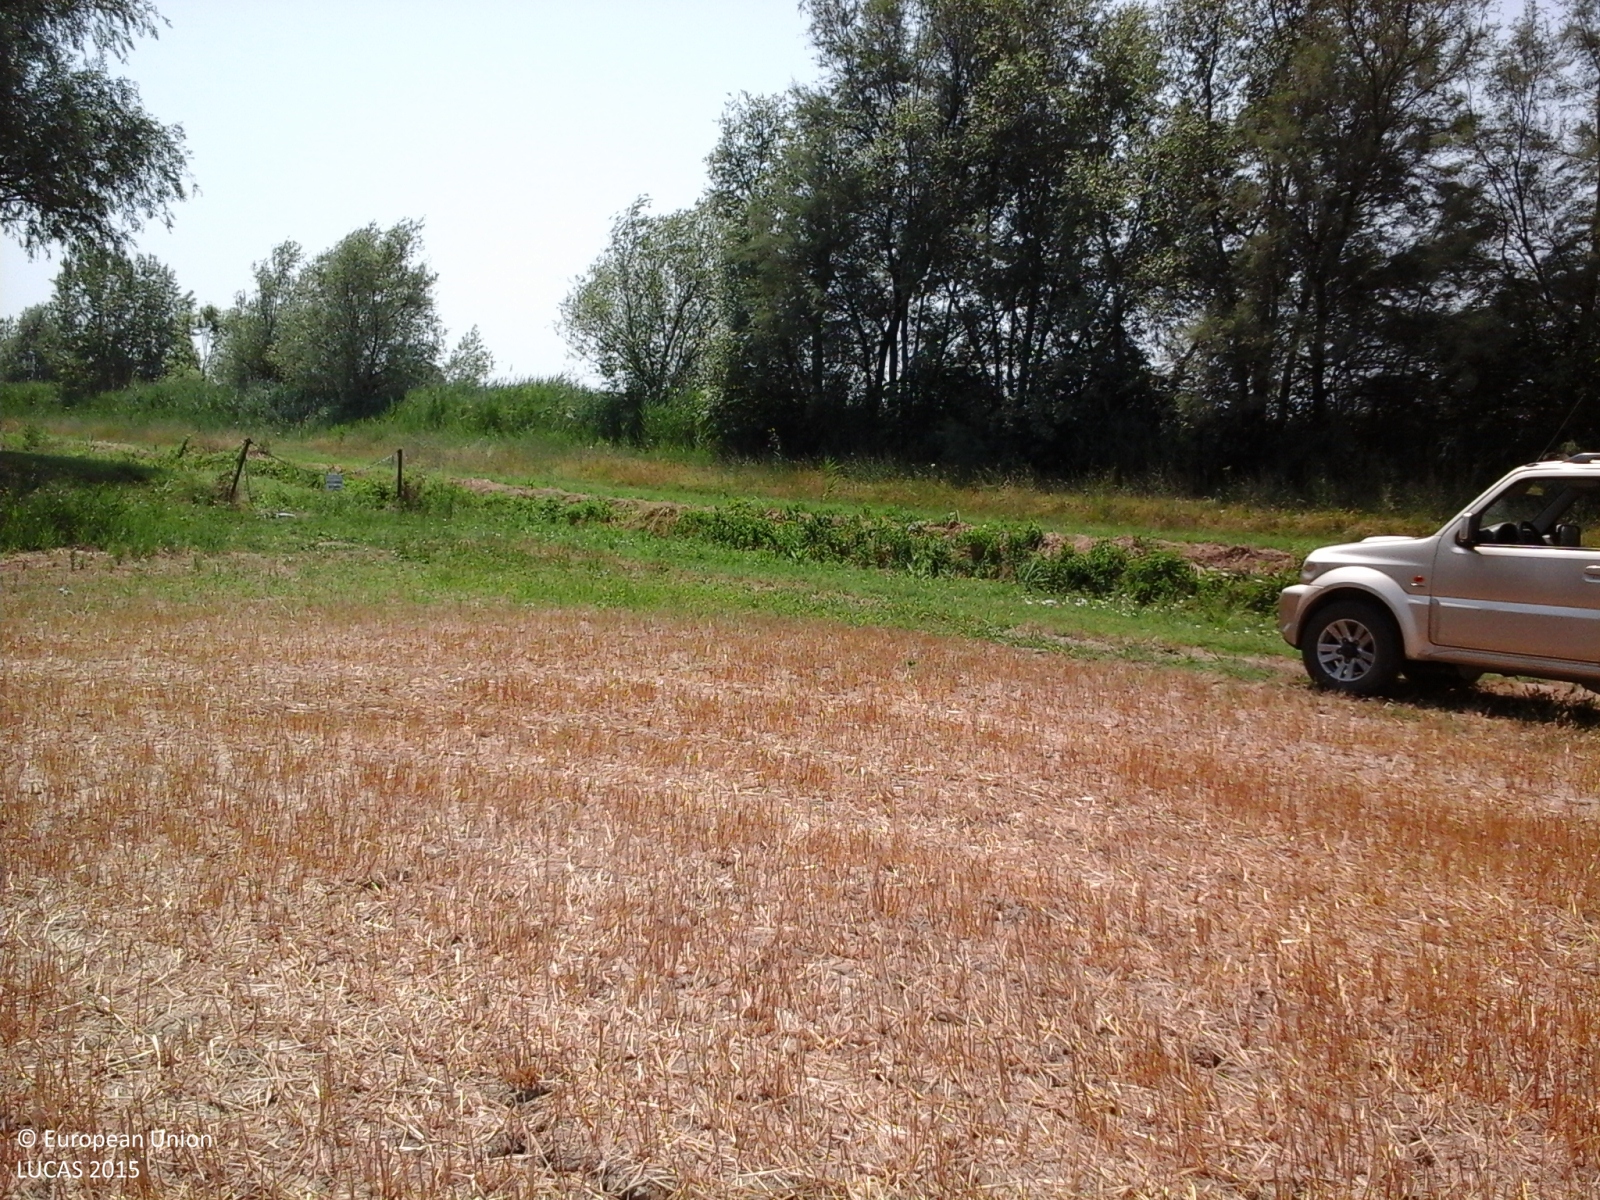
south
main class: Cropland
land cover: Barley
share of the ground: > 75 %
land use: Agriculture (excluding fallow land and kitchen gardens)
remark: Harvested field
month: July
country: IT
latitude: 44.6449
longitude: 11.5979
